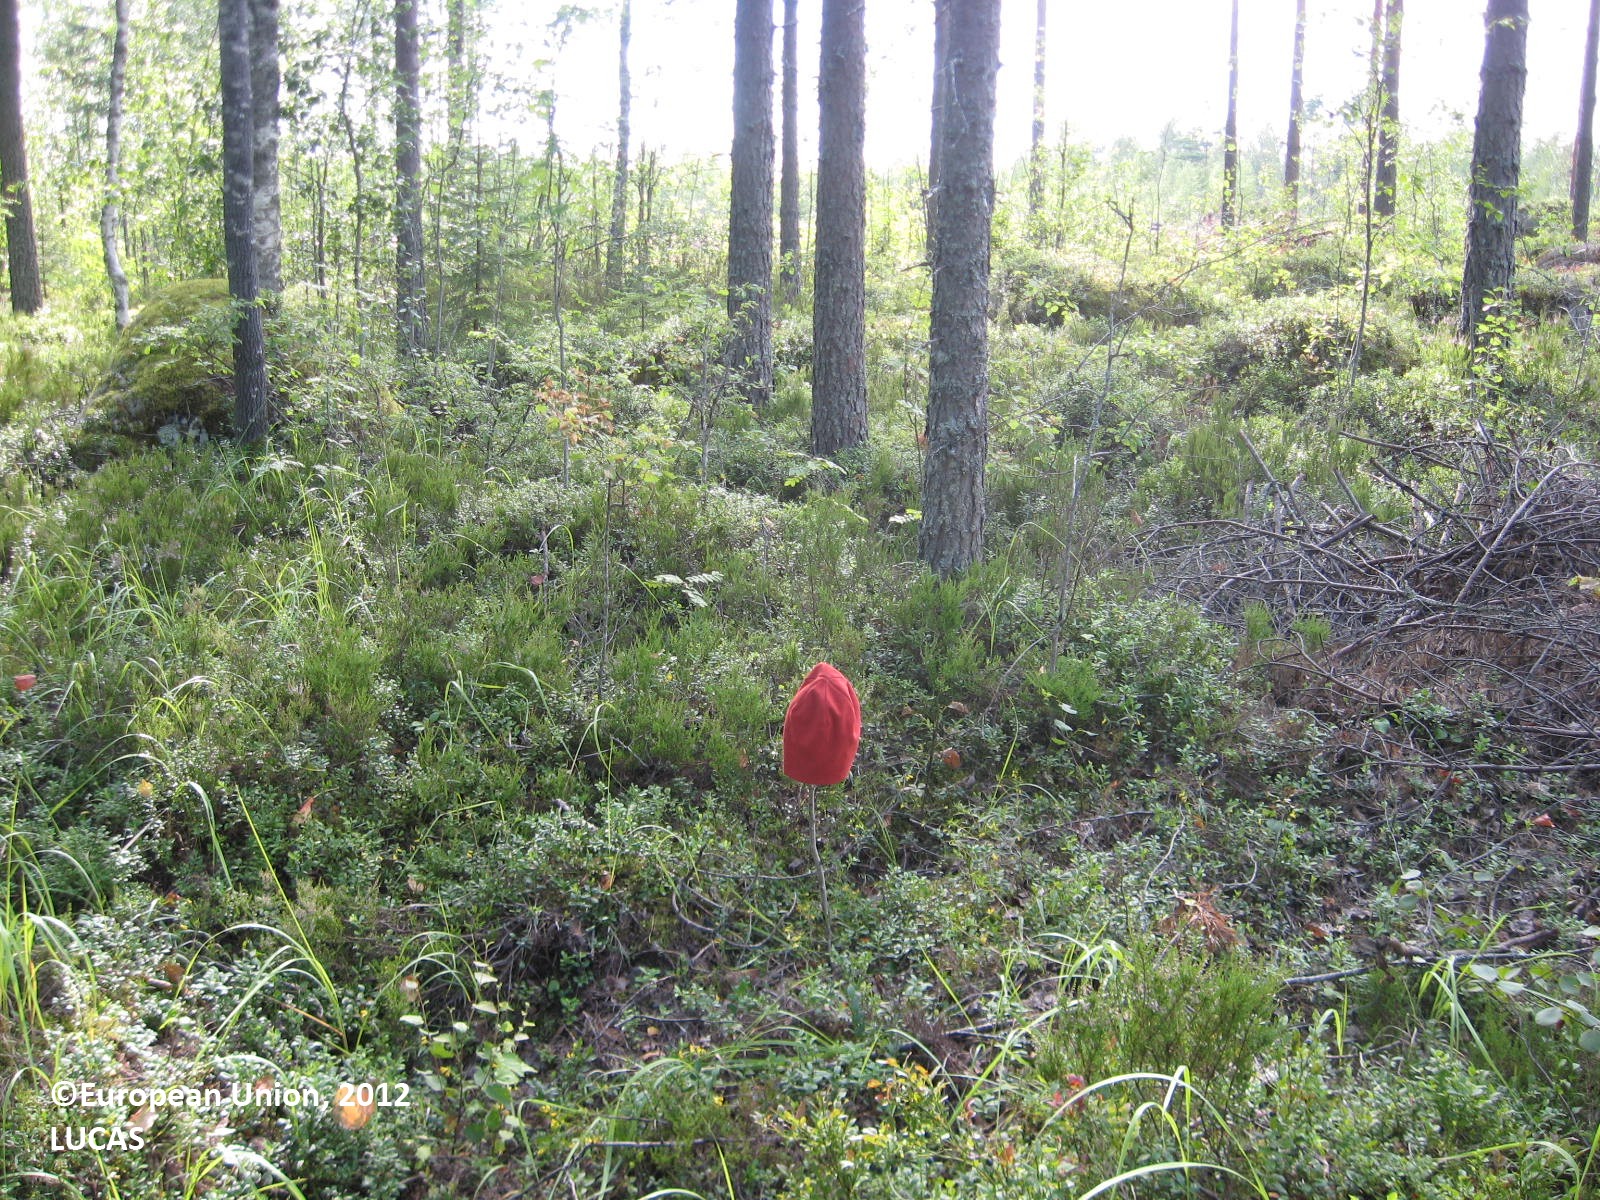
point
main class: Woodland
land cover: Other mixed woodland
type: boreal forest
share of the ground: > 75 %
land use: Forestry
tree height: > 5 m
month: July
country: FI
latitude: 61.9231
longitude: 22.7290
